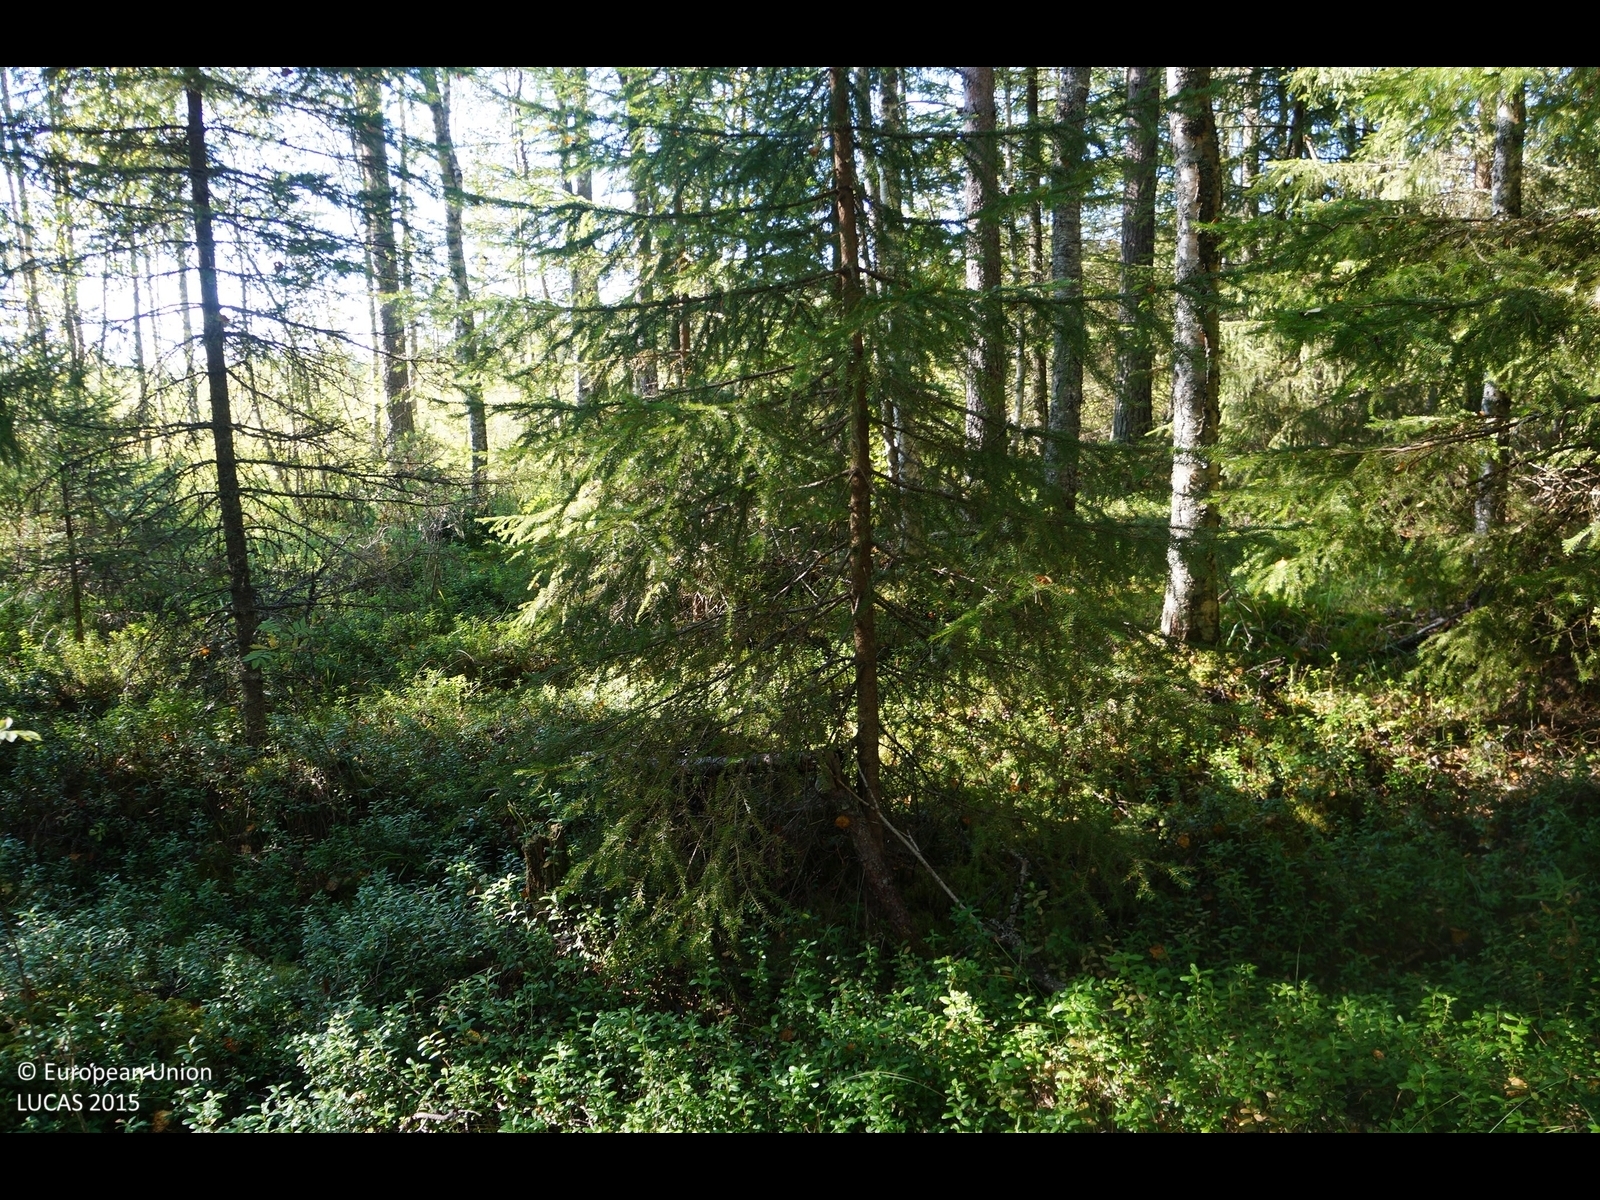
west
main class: Woodland
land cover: Other mixed woodland
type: boreal forest
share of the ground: 50 - 75 %
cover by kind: coniferous forest trees 50 %, broadleaved forest trees 20 %, shrubs 15 %, lichens and mosses 10 %, herbaceous plants 5 %
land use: Forestry
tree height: > 5 m
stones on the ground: < 10 %
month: August
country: FI
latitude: 64.1271
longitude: 25.1416
